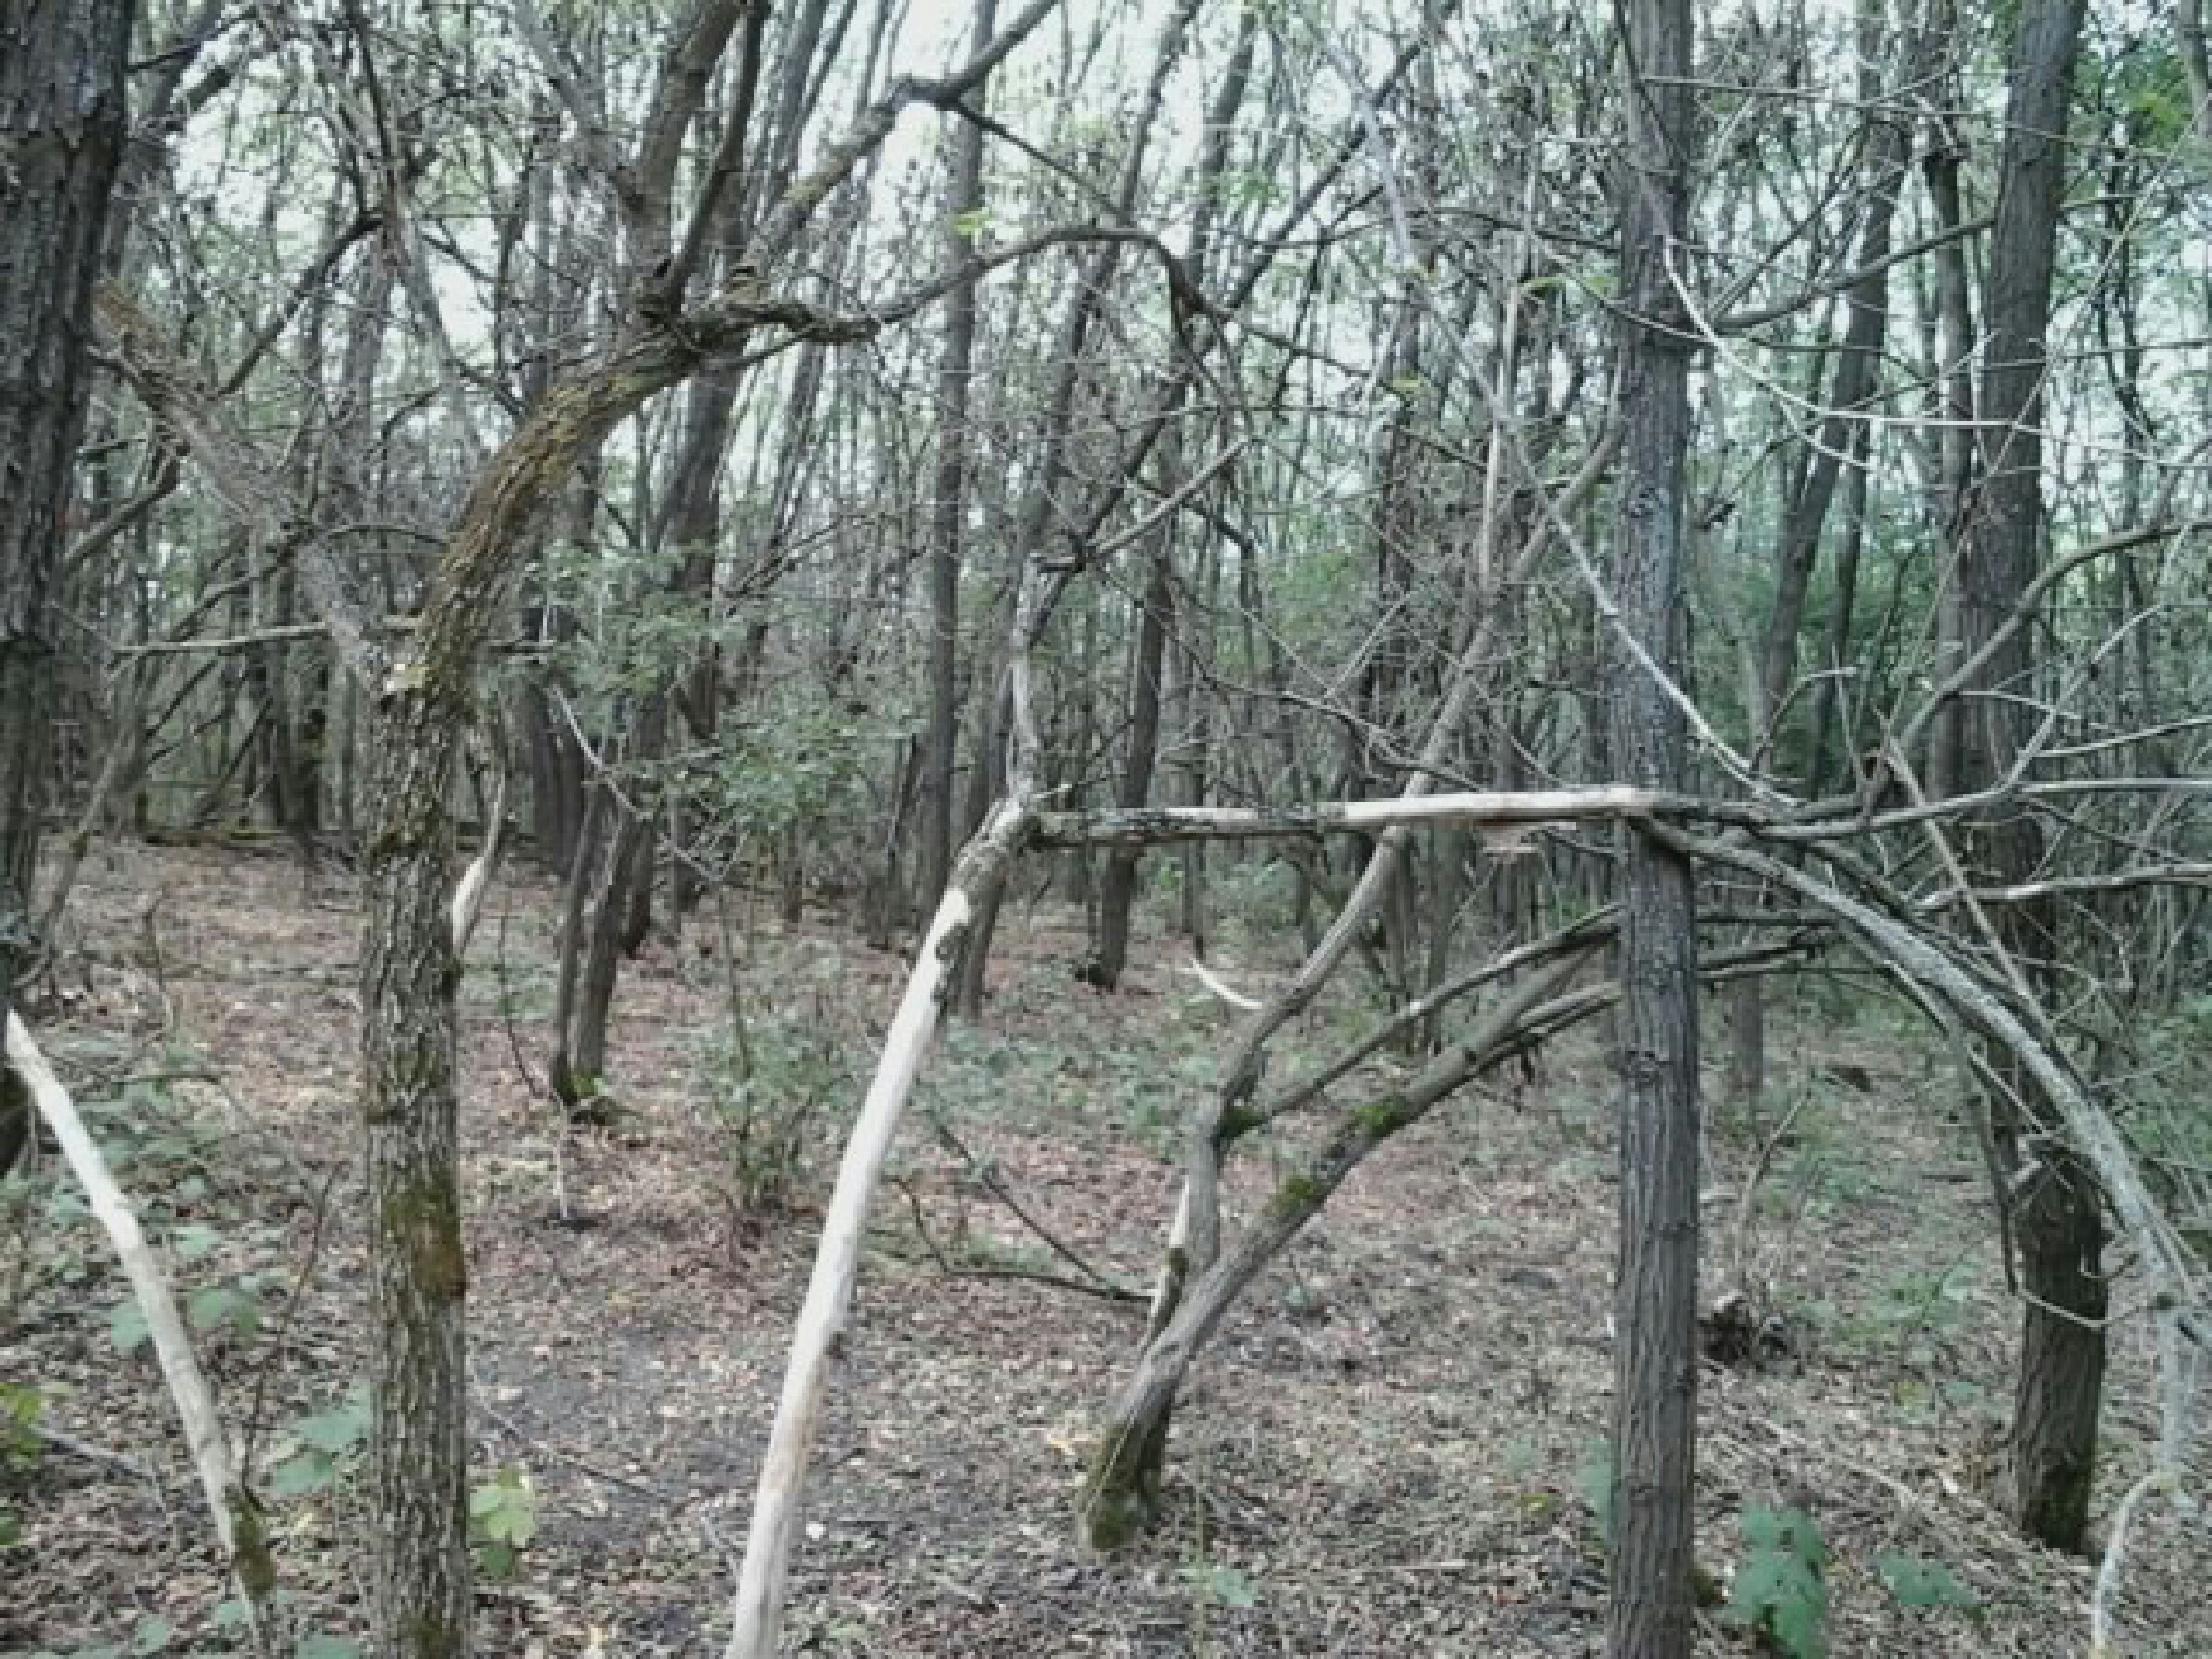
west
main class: Woodland
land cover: Broadleaved woodland
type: exotic forest
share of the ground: > 75 %
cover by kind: broadleaved forest trees 100 %
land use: Forestry
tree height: > 5 m
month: August
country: HU
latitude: 47.8535
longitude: 19.4446
